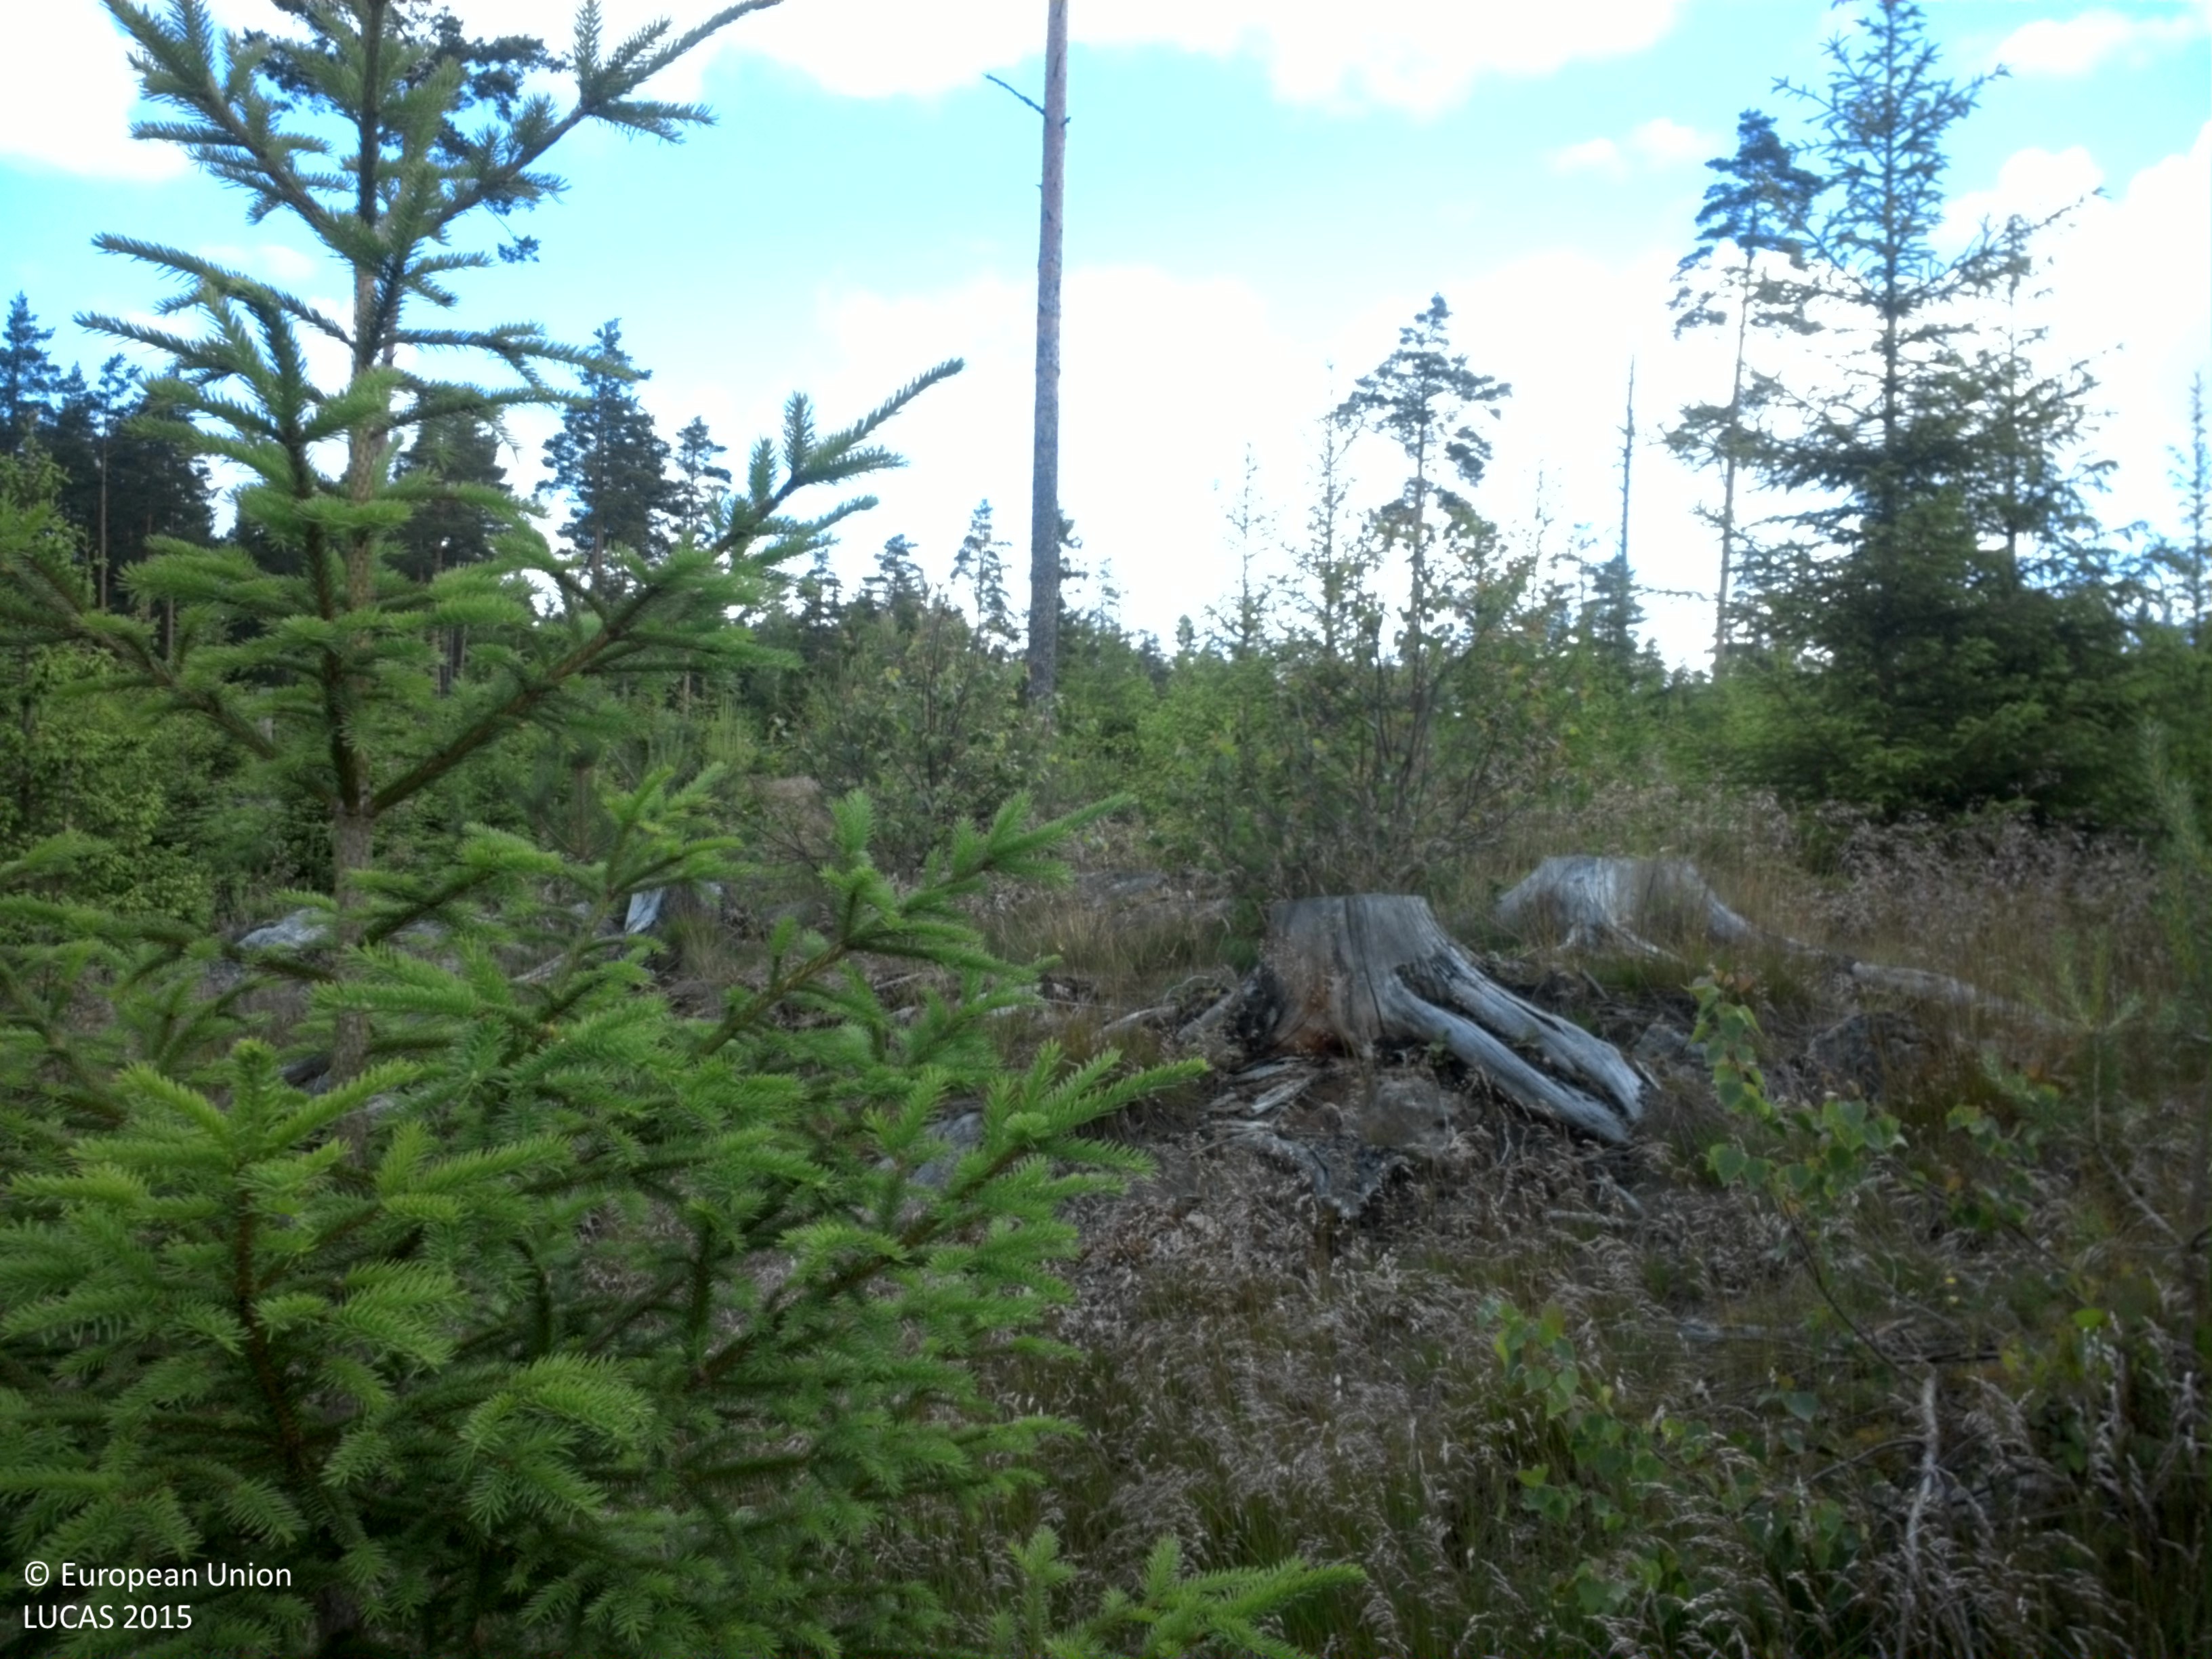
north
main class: Woodland
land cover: Spruce dominated coniferous woodland
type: boreal forest
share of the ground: 50 - 75 %
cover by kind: coniferous forest trees 60 %, herbaceous plants 30 %, broadleaved forest trees 5 %, lichens and mosses 5 %
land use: Forestry
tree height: < 5 m
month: June
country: SE
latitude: 58.6356
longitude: 15.7993
